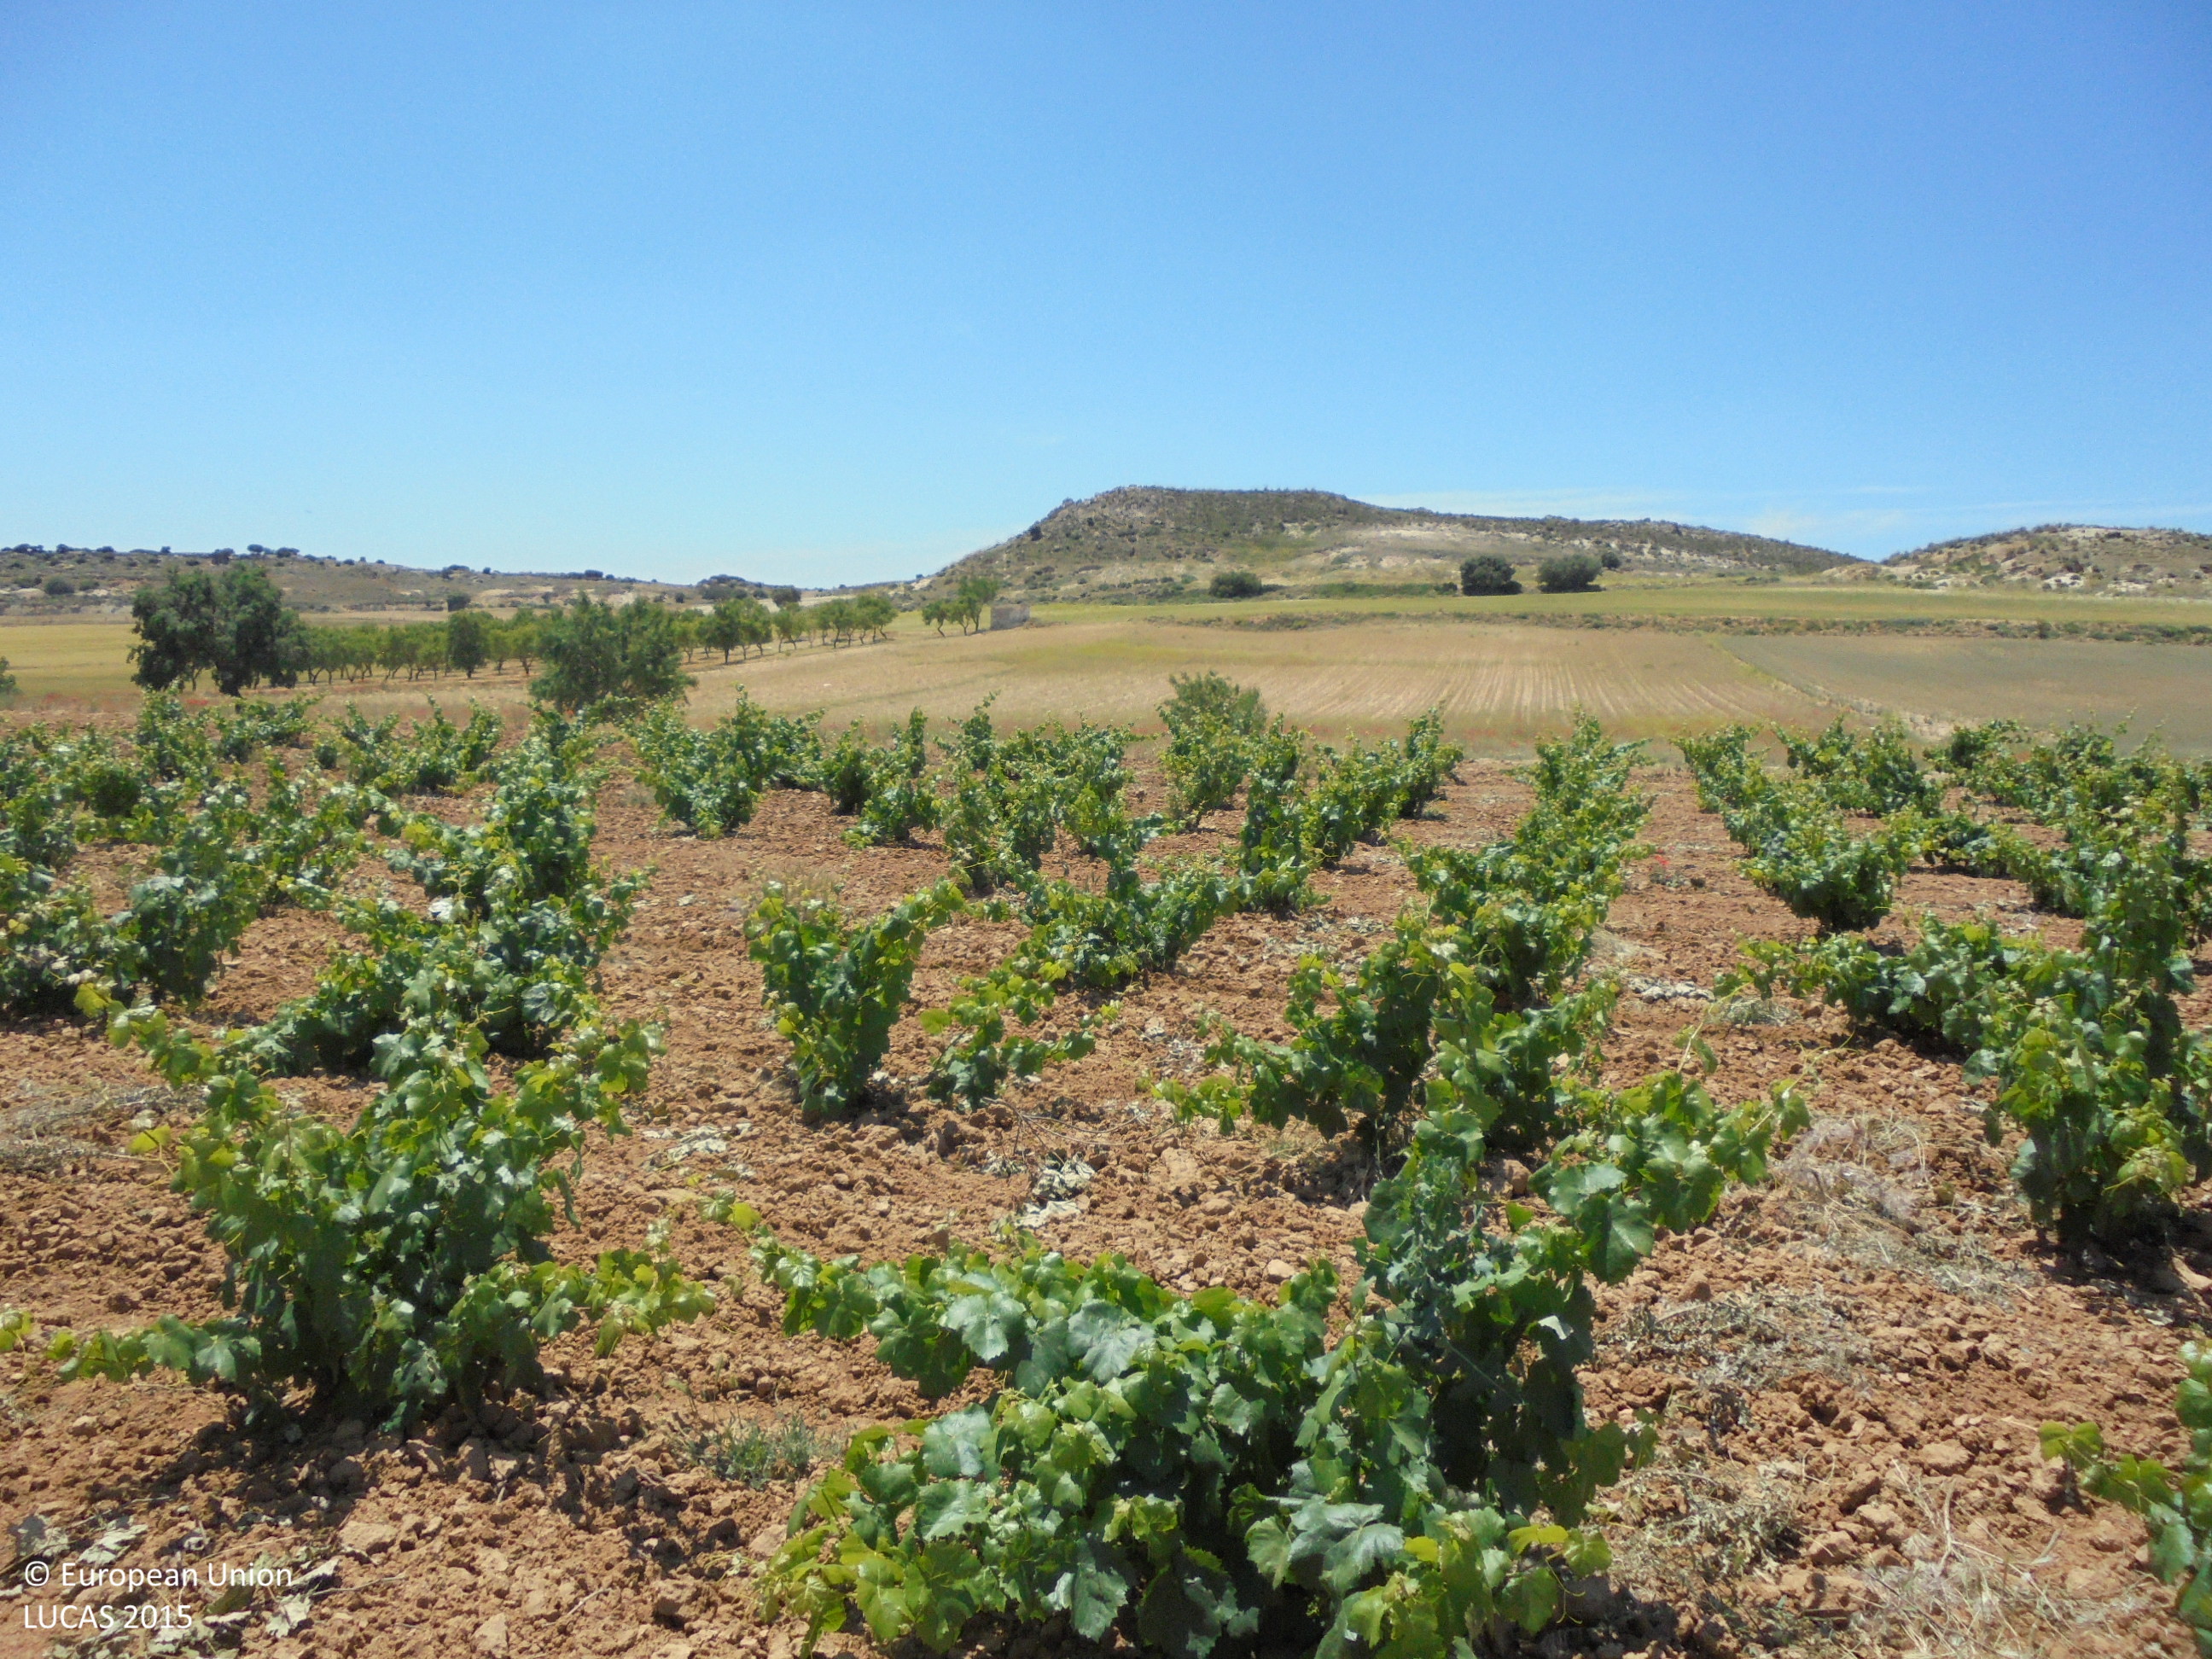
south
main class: Cropland
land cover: Vineyards
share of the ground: 25 - 50 %
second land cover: Other bare soil
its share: > 75 %
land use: Agriculture (excluding fallow land and kitchen gardens)
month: June
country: ES
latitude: 38.8309
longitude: -1.5734
